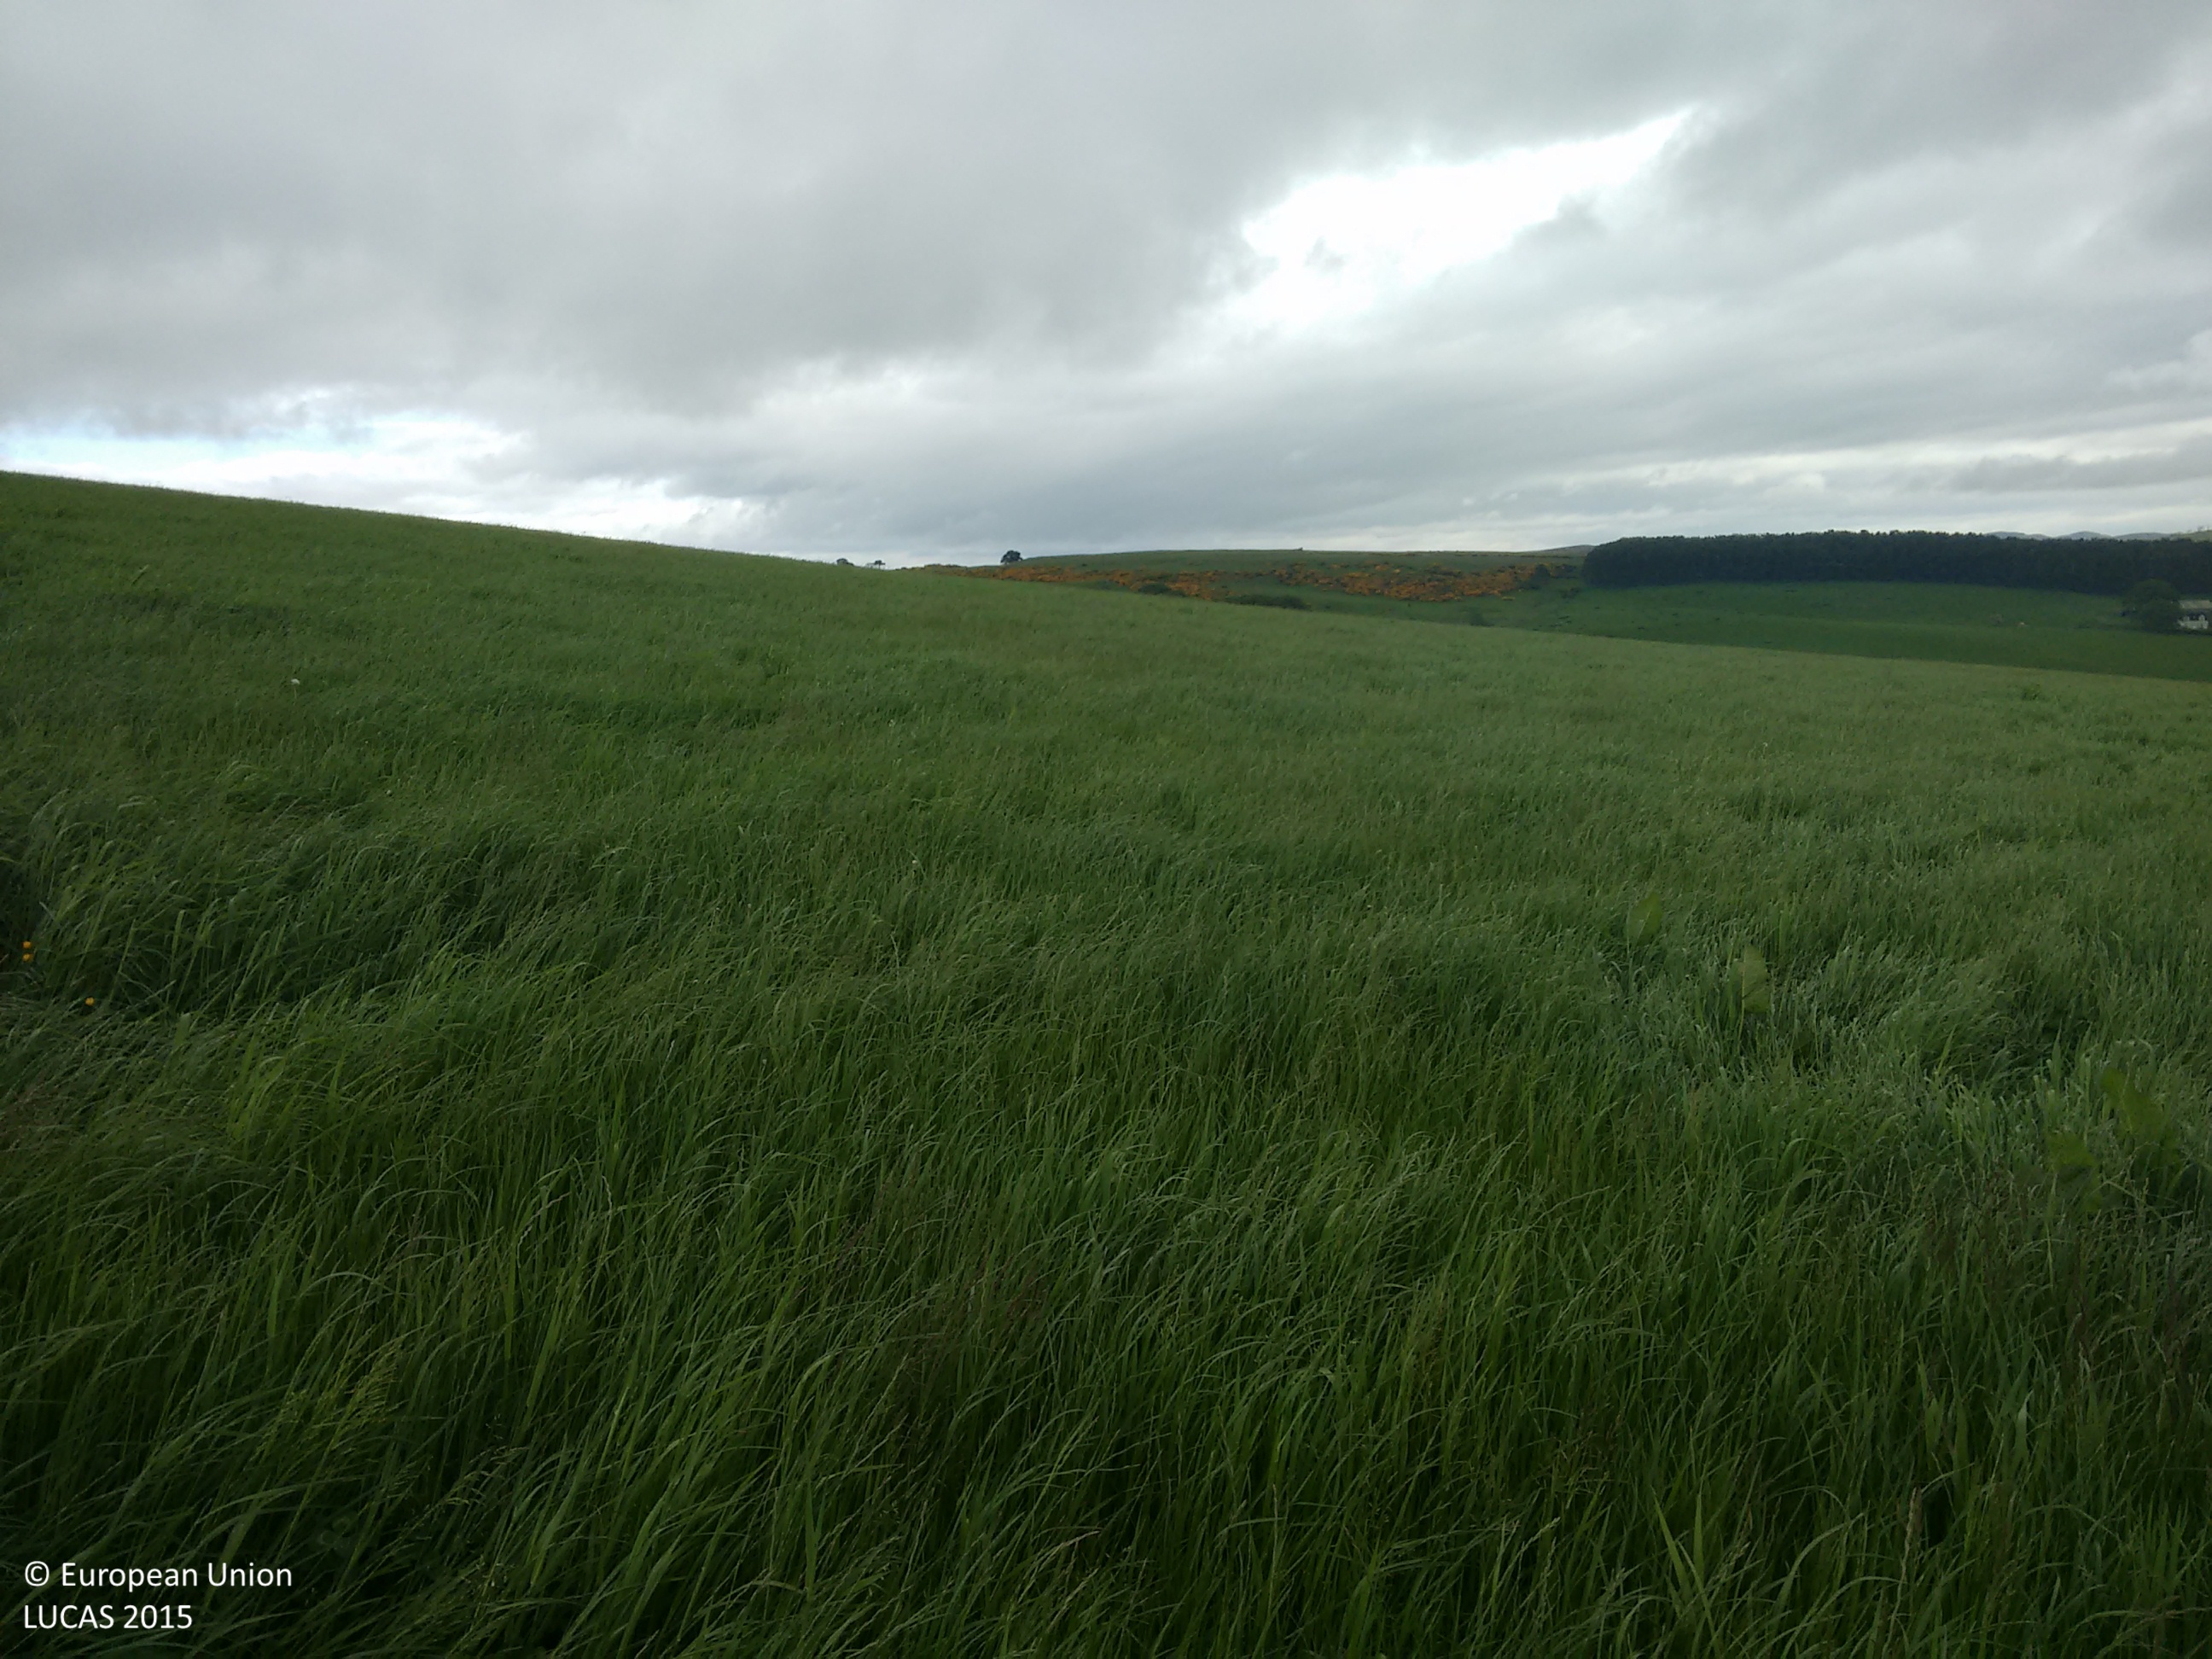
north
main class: Grassland
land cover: Grassland without tree/shrub cover
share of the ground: > 75 %
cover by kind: herbaceous plants 100 %
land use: Agriculture (excluding fallow land and kitchen gardens)
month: June
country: GB
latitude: 56.3996
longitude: -3.3423
